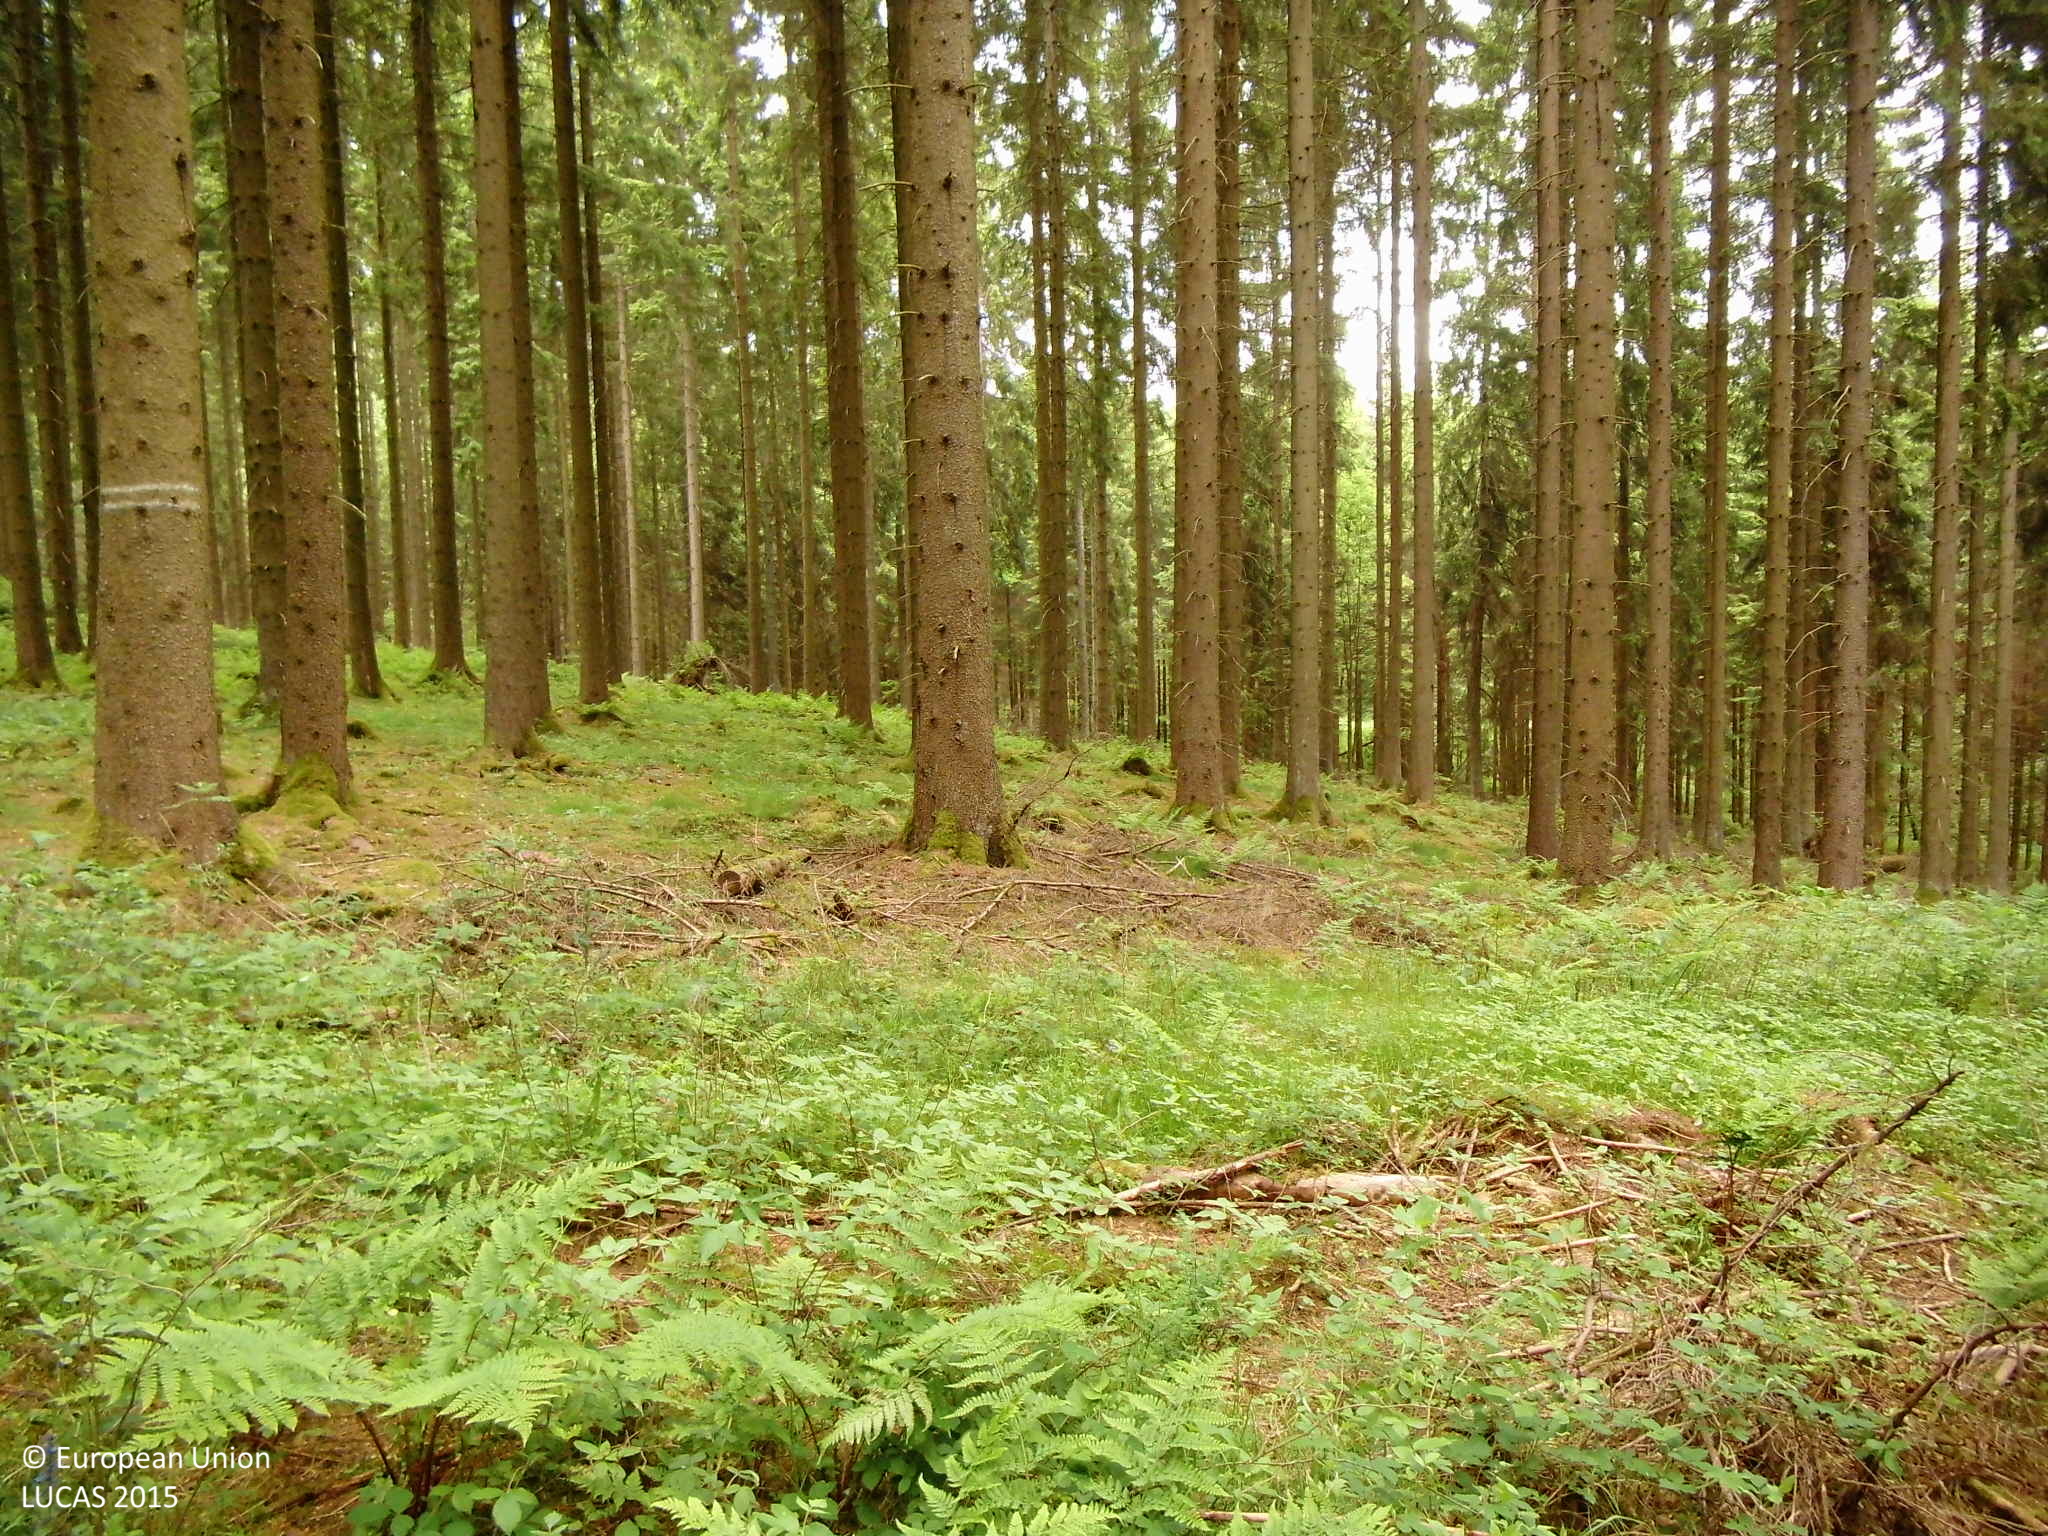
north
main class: Woodland
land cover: Spruce dominated coniferous woodland
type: hemiboreal forest and nemoral coniferous forest and mixed broadleaved-coniferous forest
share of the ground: > 75 %
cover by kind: coniferous forest trees 75 %, shrubs 10 %, lichens and mosses 10 %, herbaceous plants 5 %
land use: Forestry
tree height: > 5 m
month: June
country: DE
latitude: 51.0488
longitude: 8.0461
